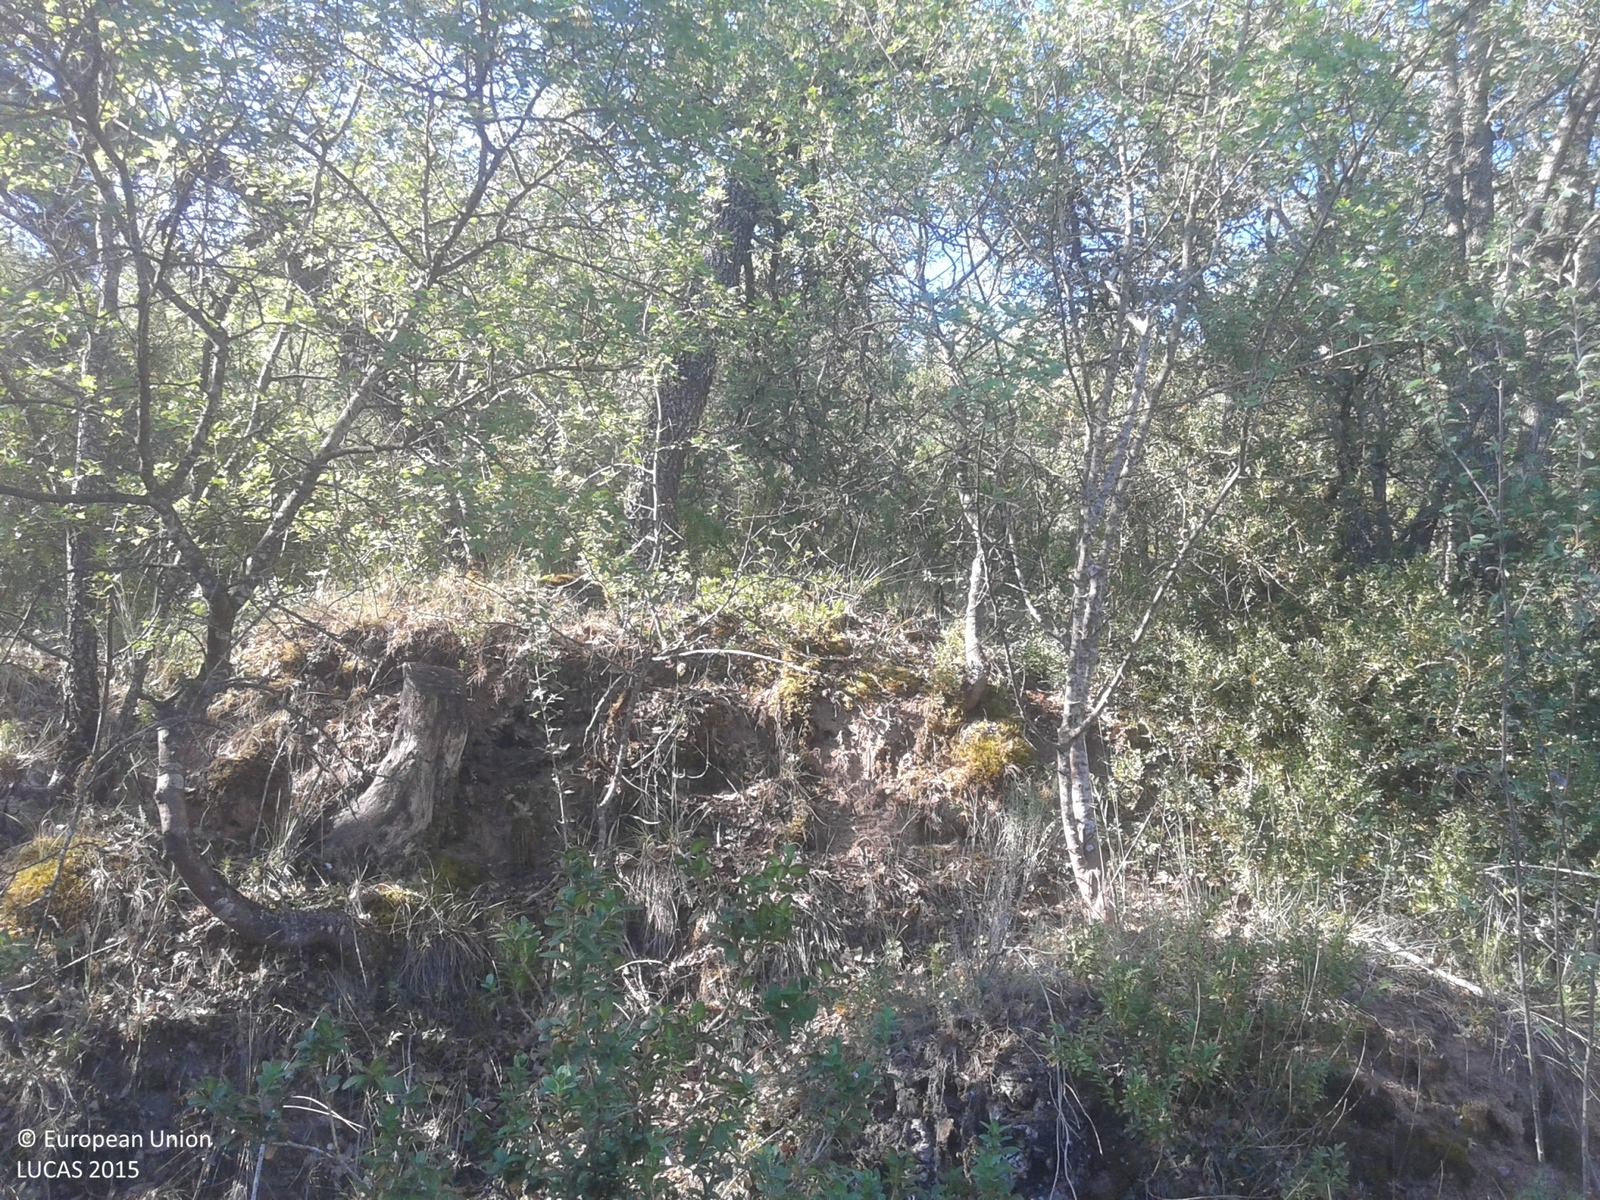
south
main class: Woodland
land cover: Broadleaved woodland
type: thermophilous deciduous forest
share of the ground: > 75 %
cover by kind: broadleaved forest trees 70 %, shrubs 15 %, coniferous forest trees 10 %, herbaceous plants 5 %
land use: Semi-natural and natural areas not in use
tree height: > 5 m
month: May
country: ES
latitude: 41.9008
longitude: 1.1279
